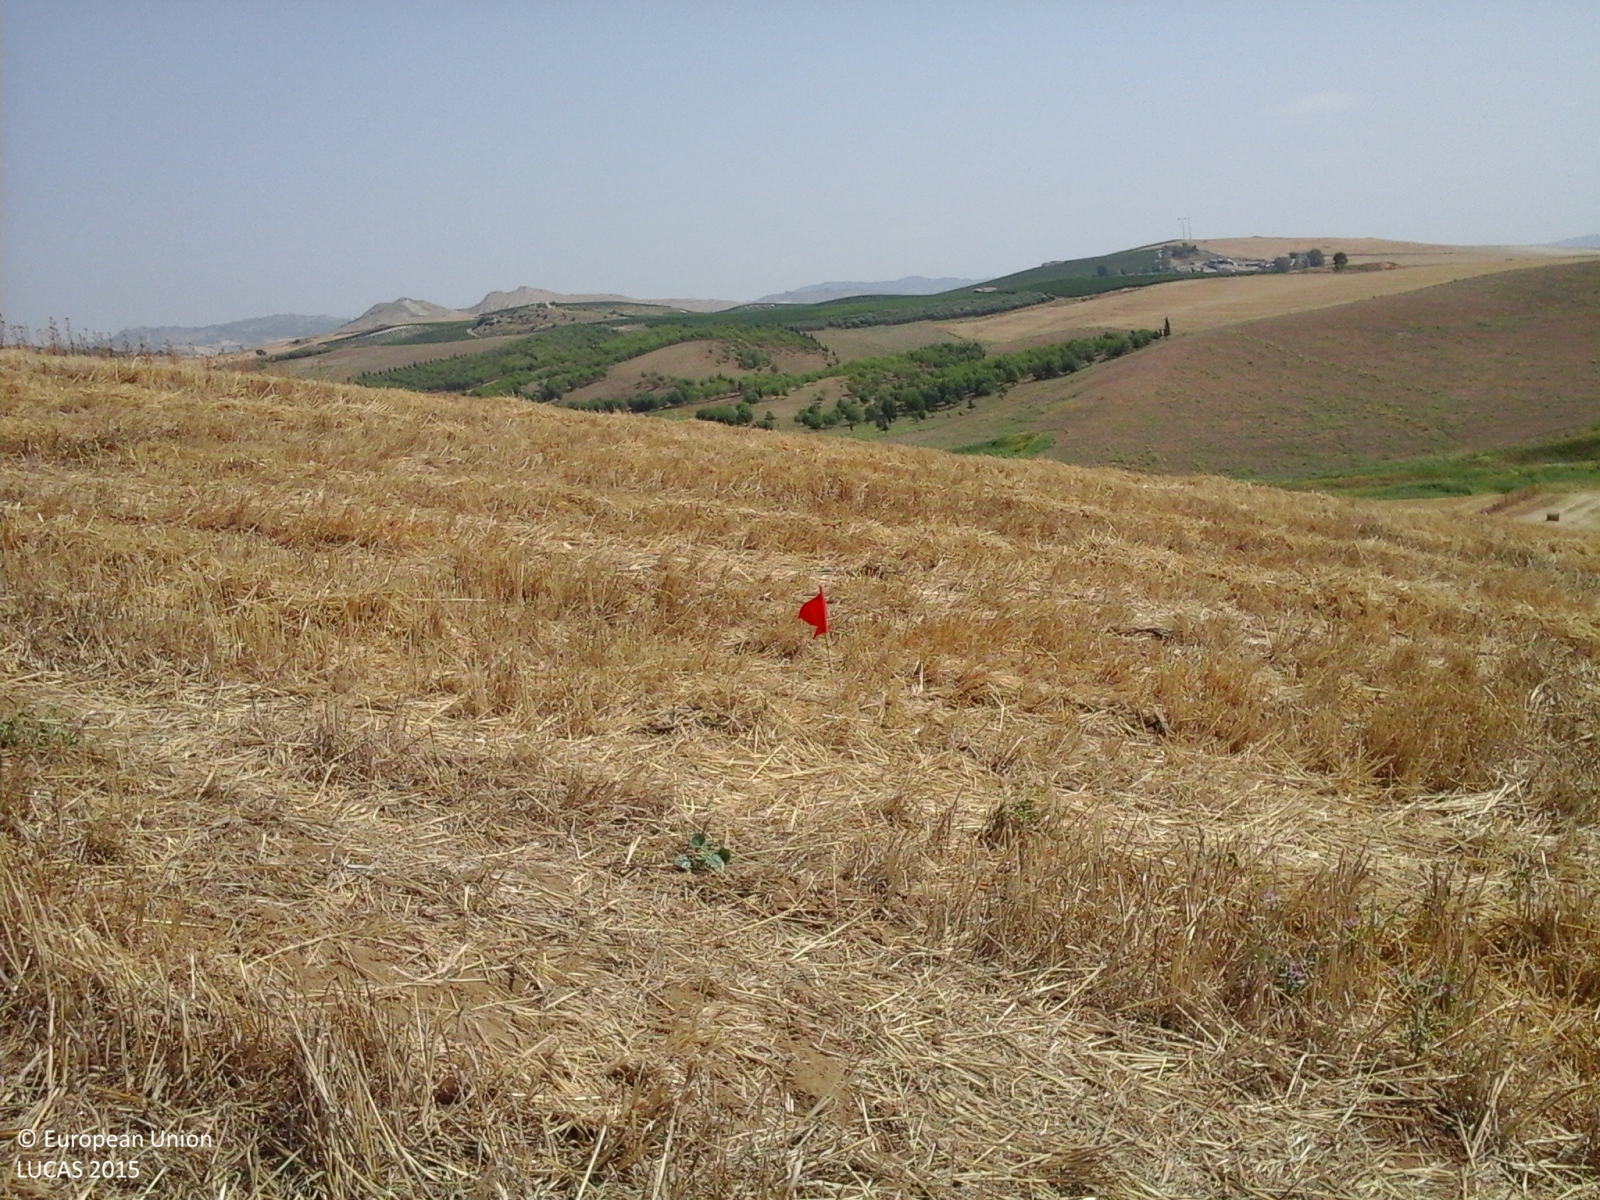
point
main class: Cropland
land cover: Durum wheat
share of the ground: > 75 %
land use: Agriculture (excluding fallow land and kitchen gardens)
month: July
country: IT
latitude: 37.3916
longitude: 13.9795
